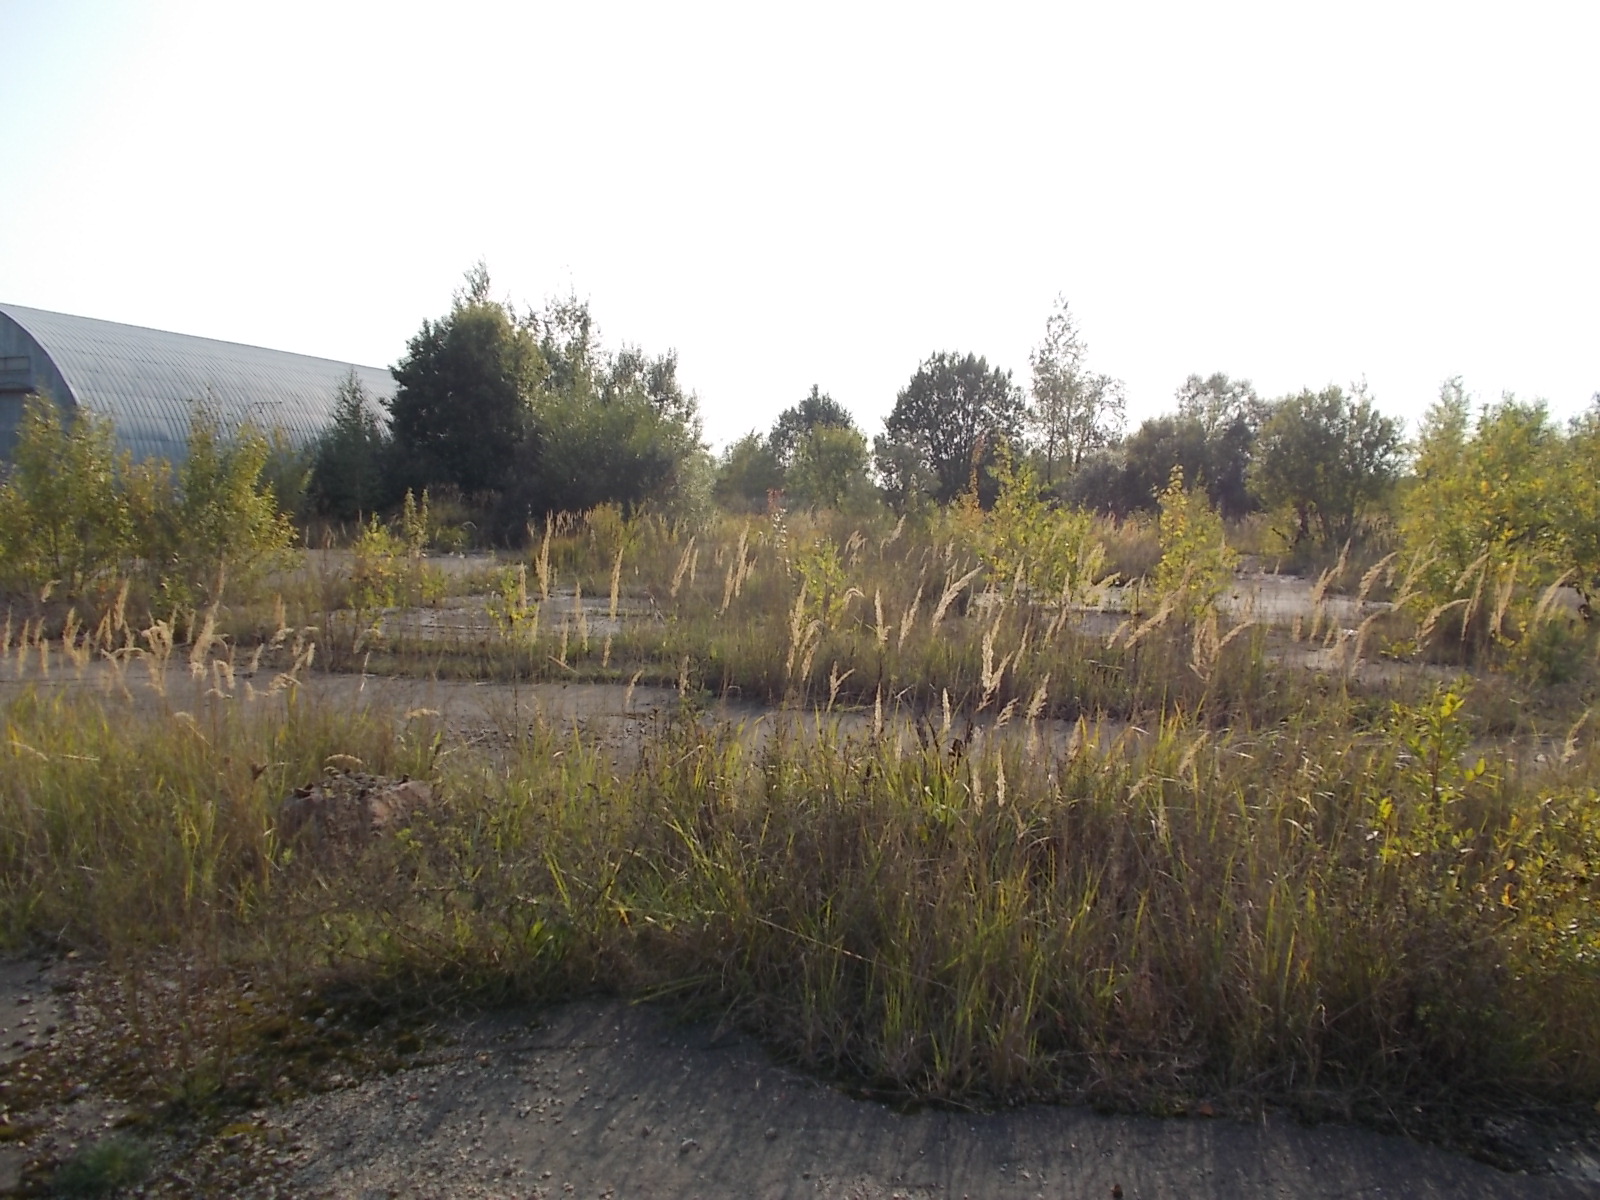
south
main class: Grassland
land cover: Spontaneously vegetated surfaces
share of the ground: 25 - 50 %
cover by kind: herbaceous plants 35 %
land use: Abandoned areas
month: September
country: LV
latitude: 56.9387
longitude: 23.6016
